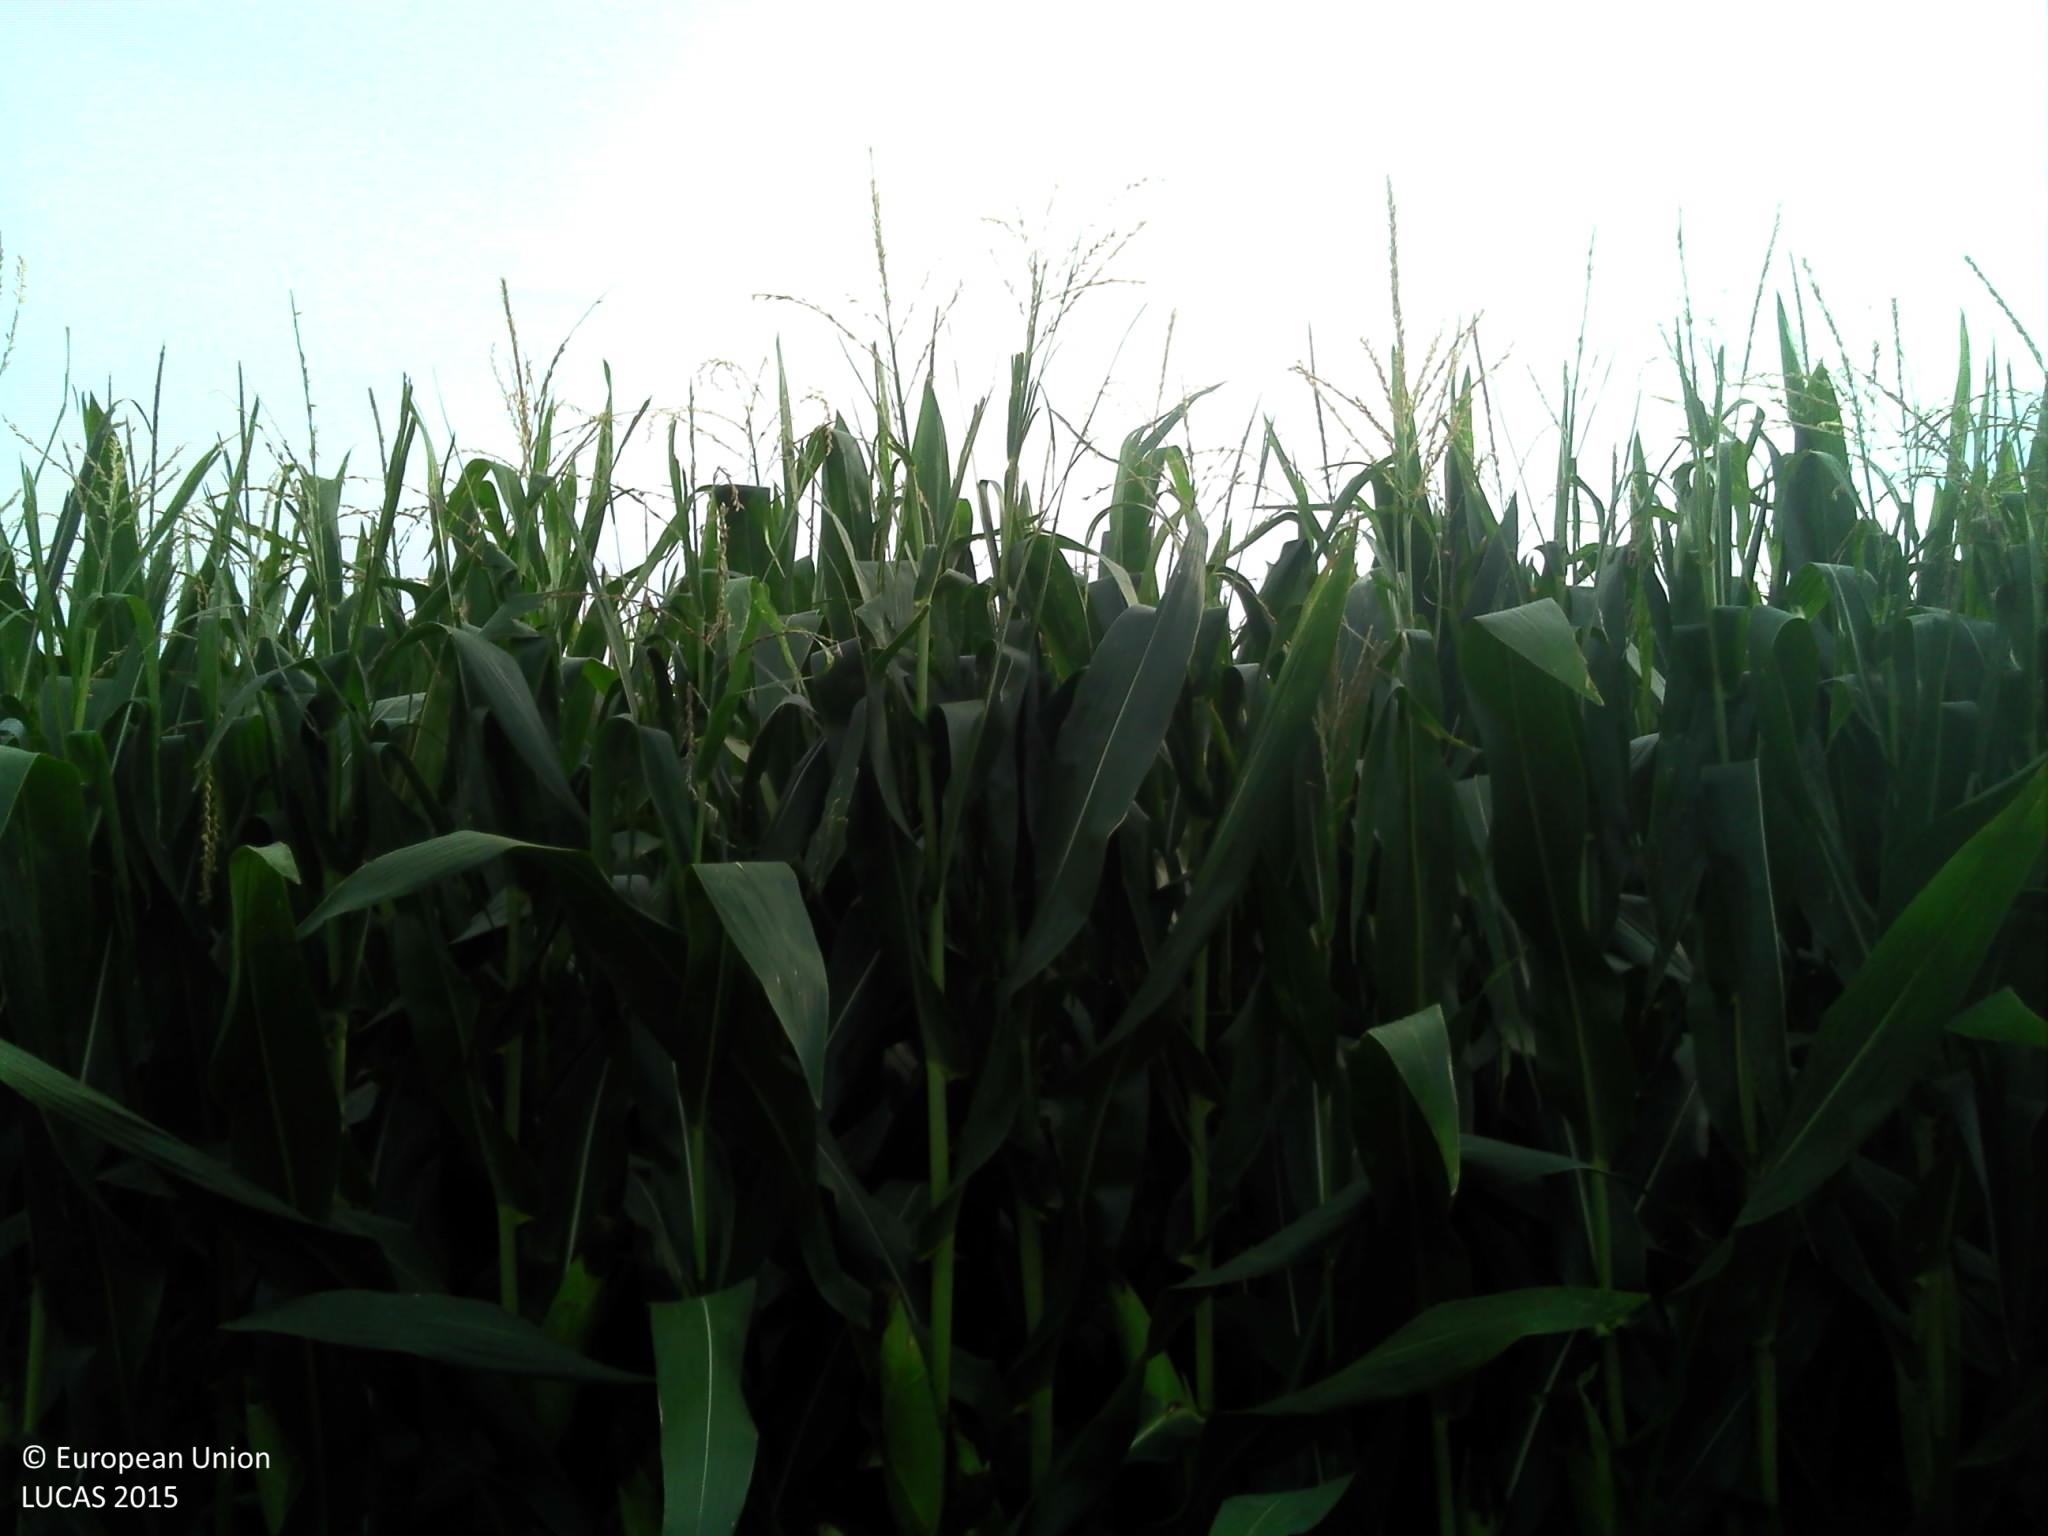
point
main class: Cropland
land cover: Maize
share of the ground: > 75 %
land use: Agriculture (excluding fallow land and kitchen gardens)
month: July
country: FR
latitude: 45.7112
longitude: 5.0068
